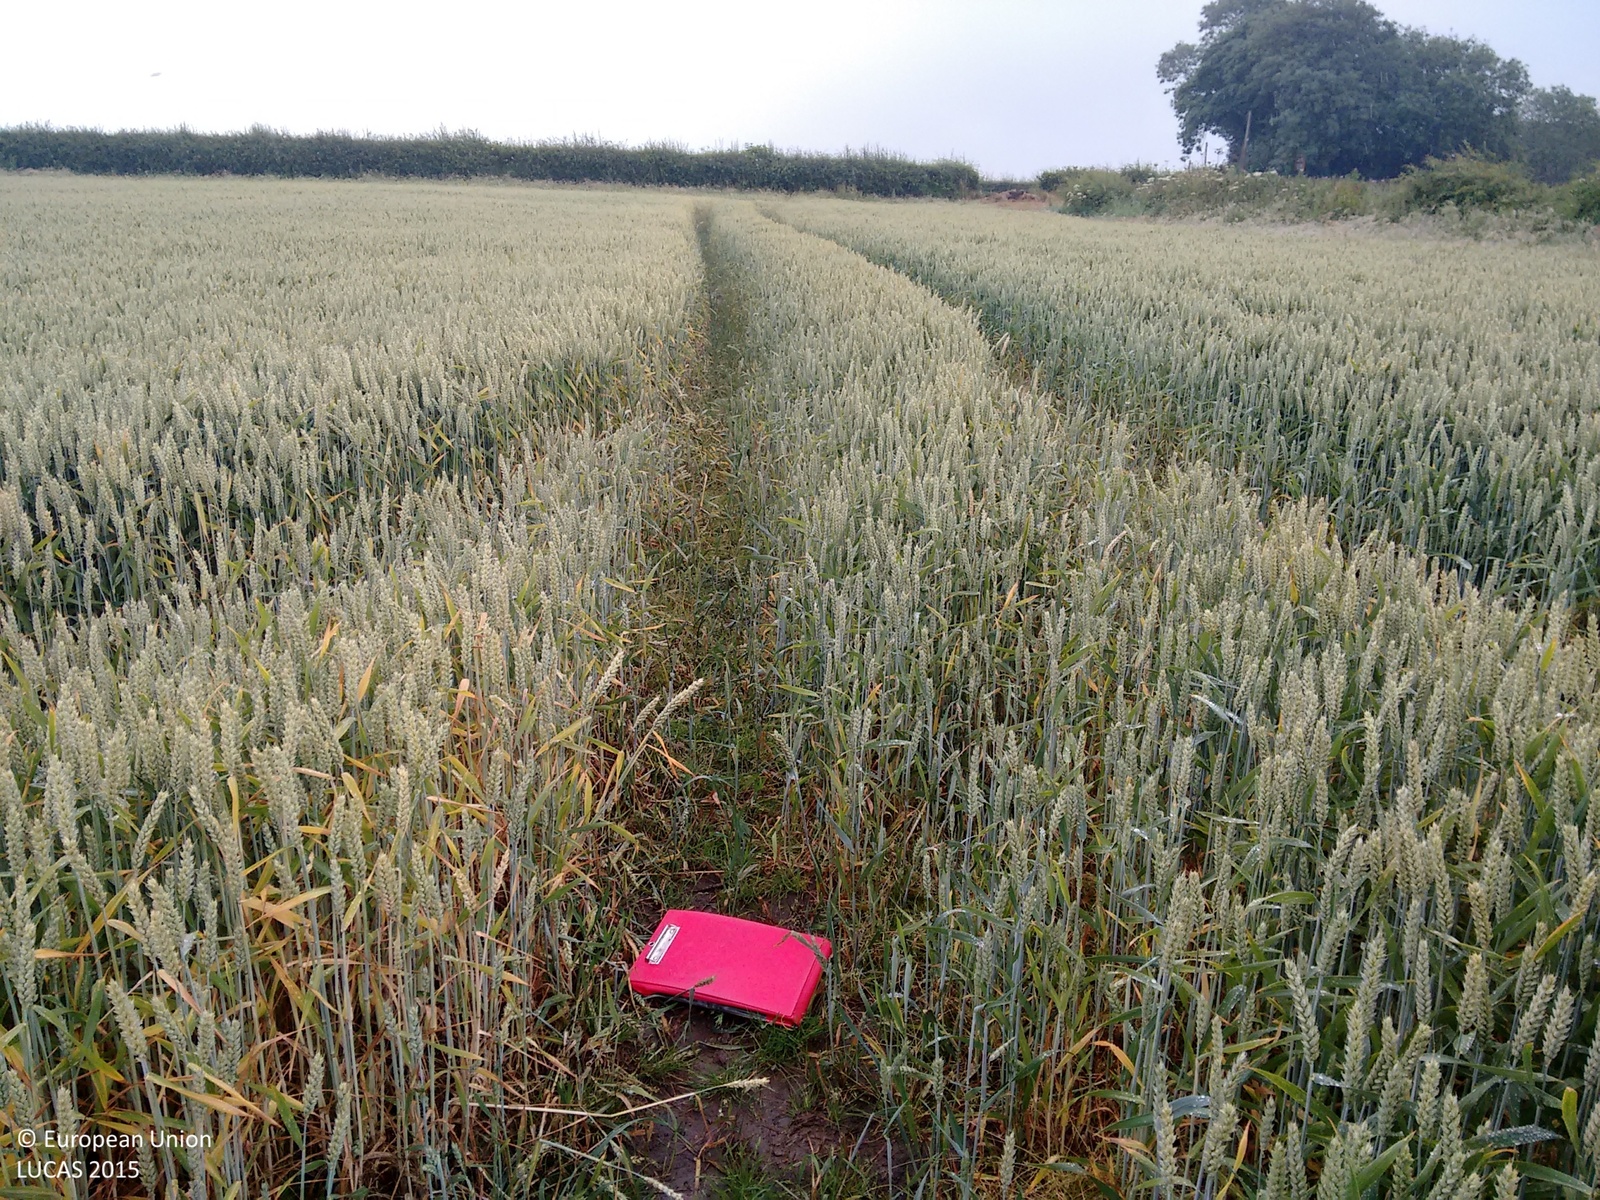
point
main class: Cropland
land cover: Common wheat
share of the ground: > 75 %
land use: Agriculture (excluding fallow land and kitchen gardens)
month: July
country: GB
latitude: 53.4483
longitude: -2.7938
